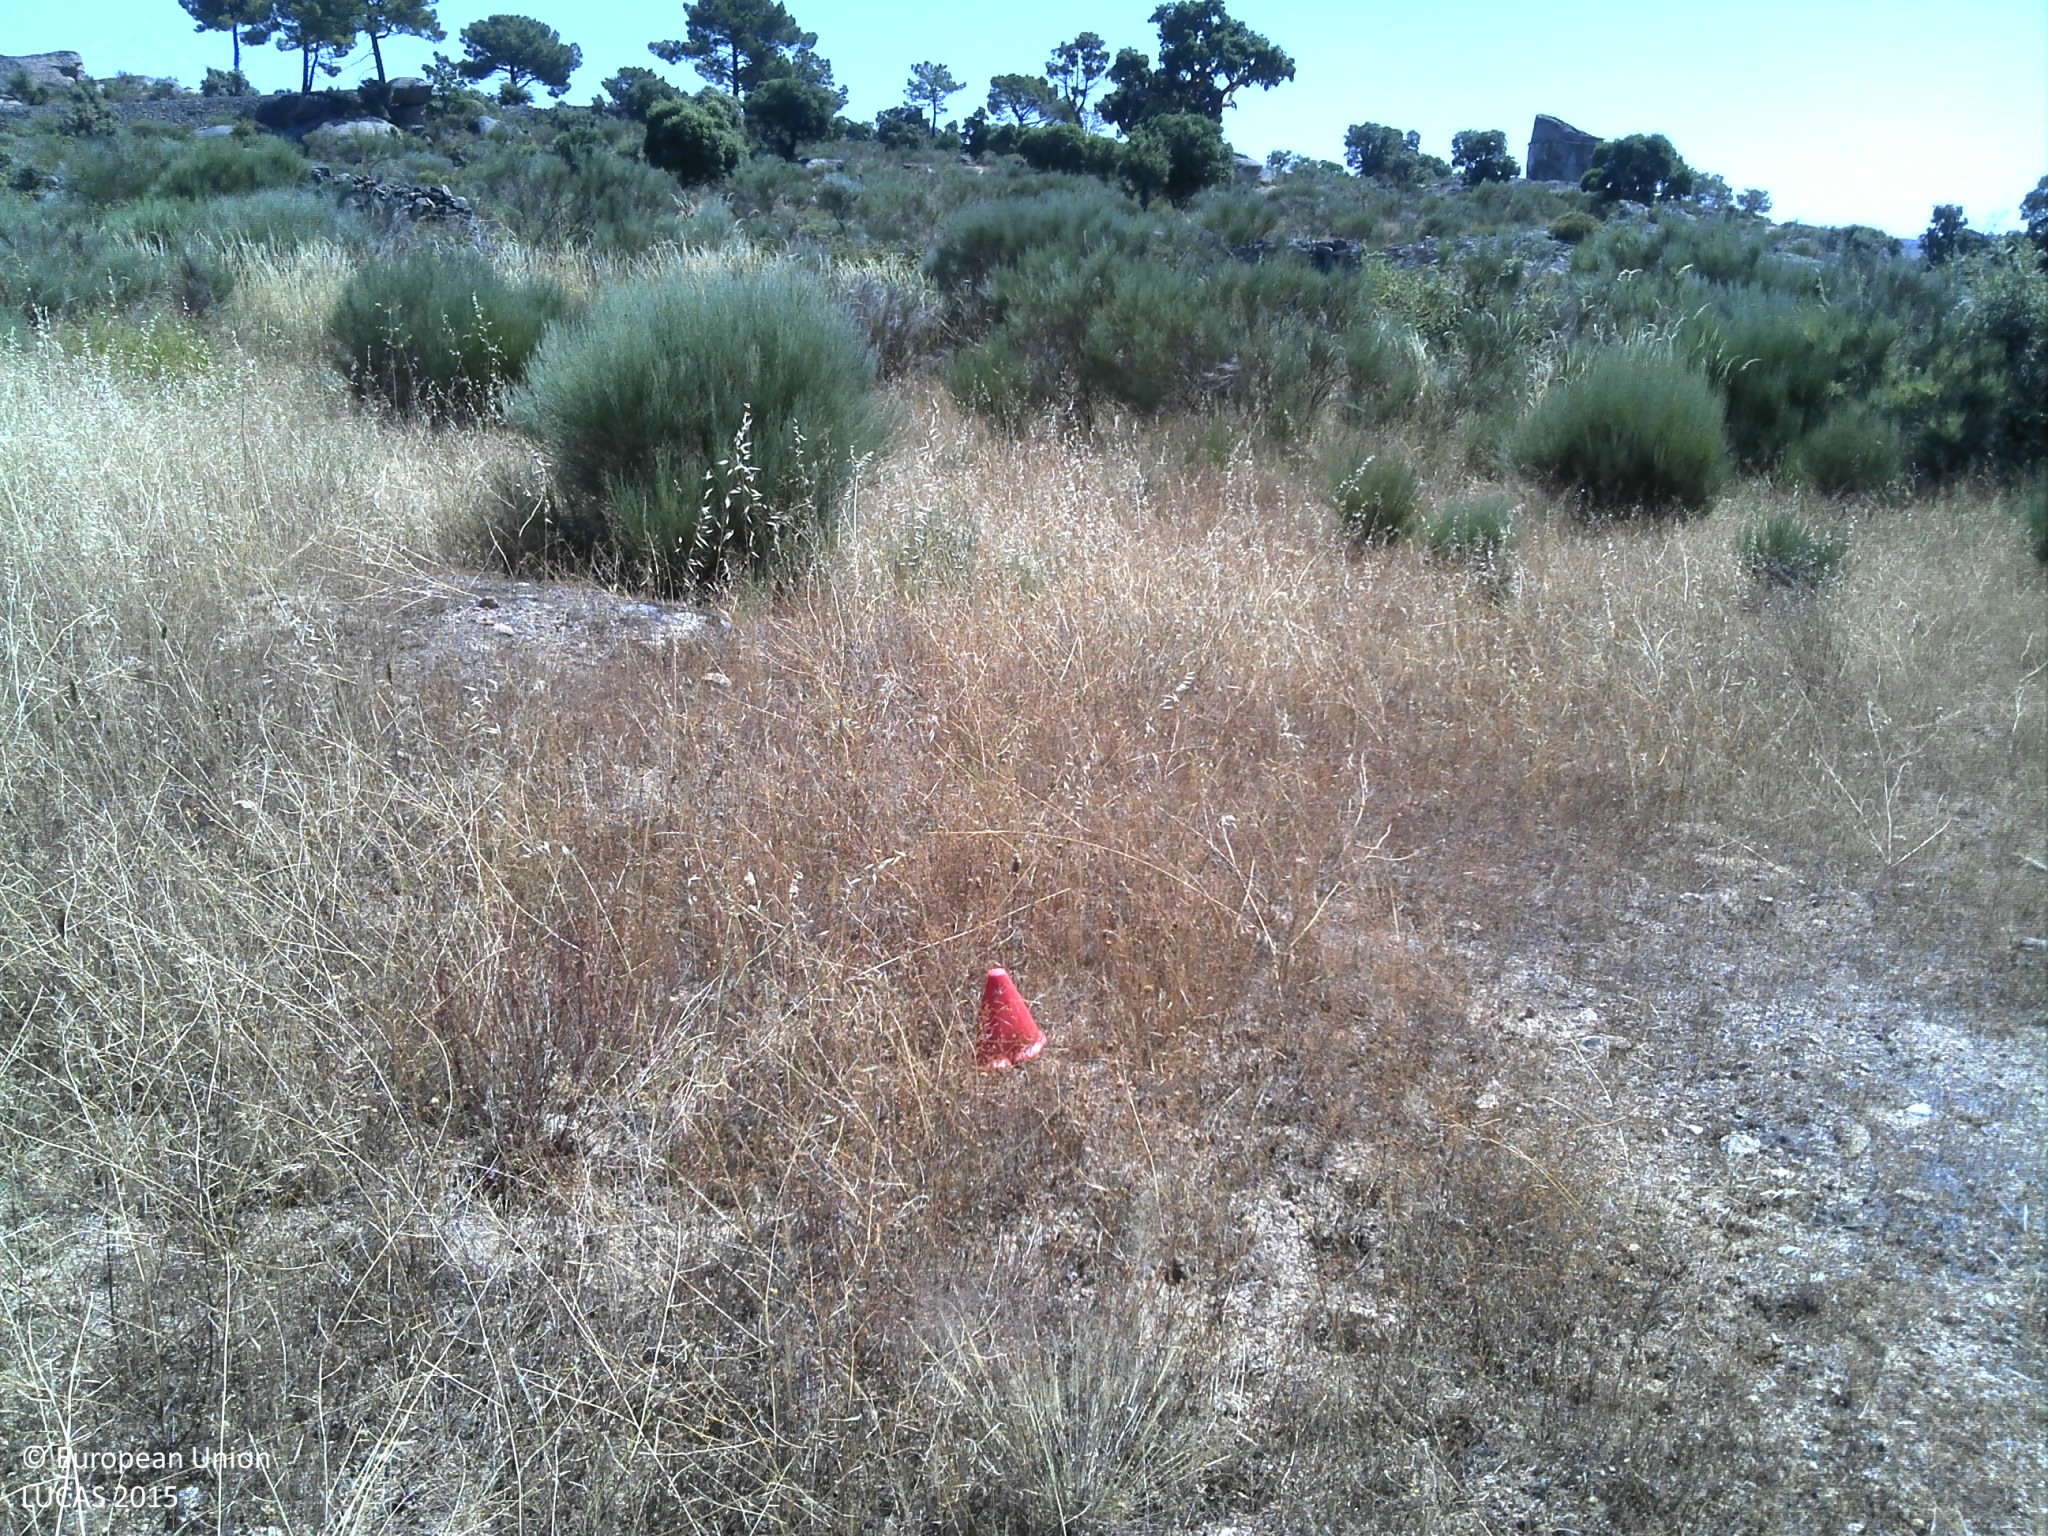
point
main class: Shrubland
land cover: Shrubland without tree cover
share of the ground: 25 - 50 %
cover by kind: herbaceous plants 40 %, shrubs 30 %, unconsolidated bare surface 30 %
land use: Fallow land
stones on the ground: < 10 %
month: June
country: PT
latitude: 40.9746
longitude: -6.9447
